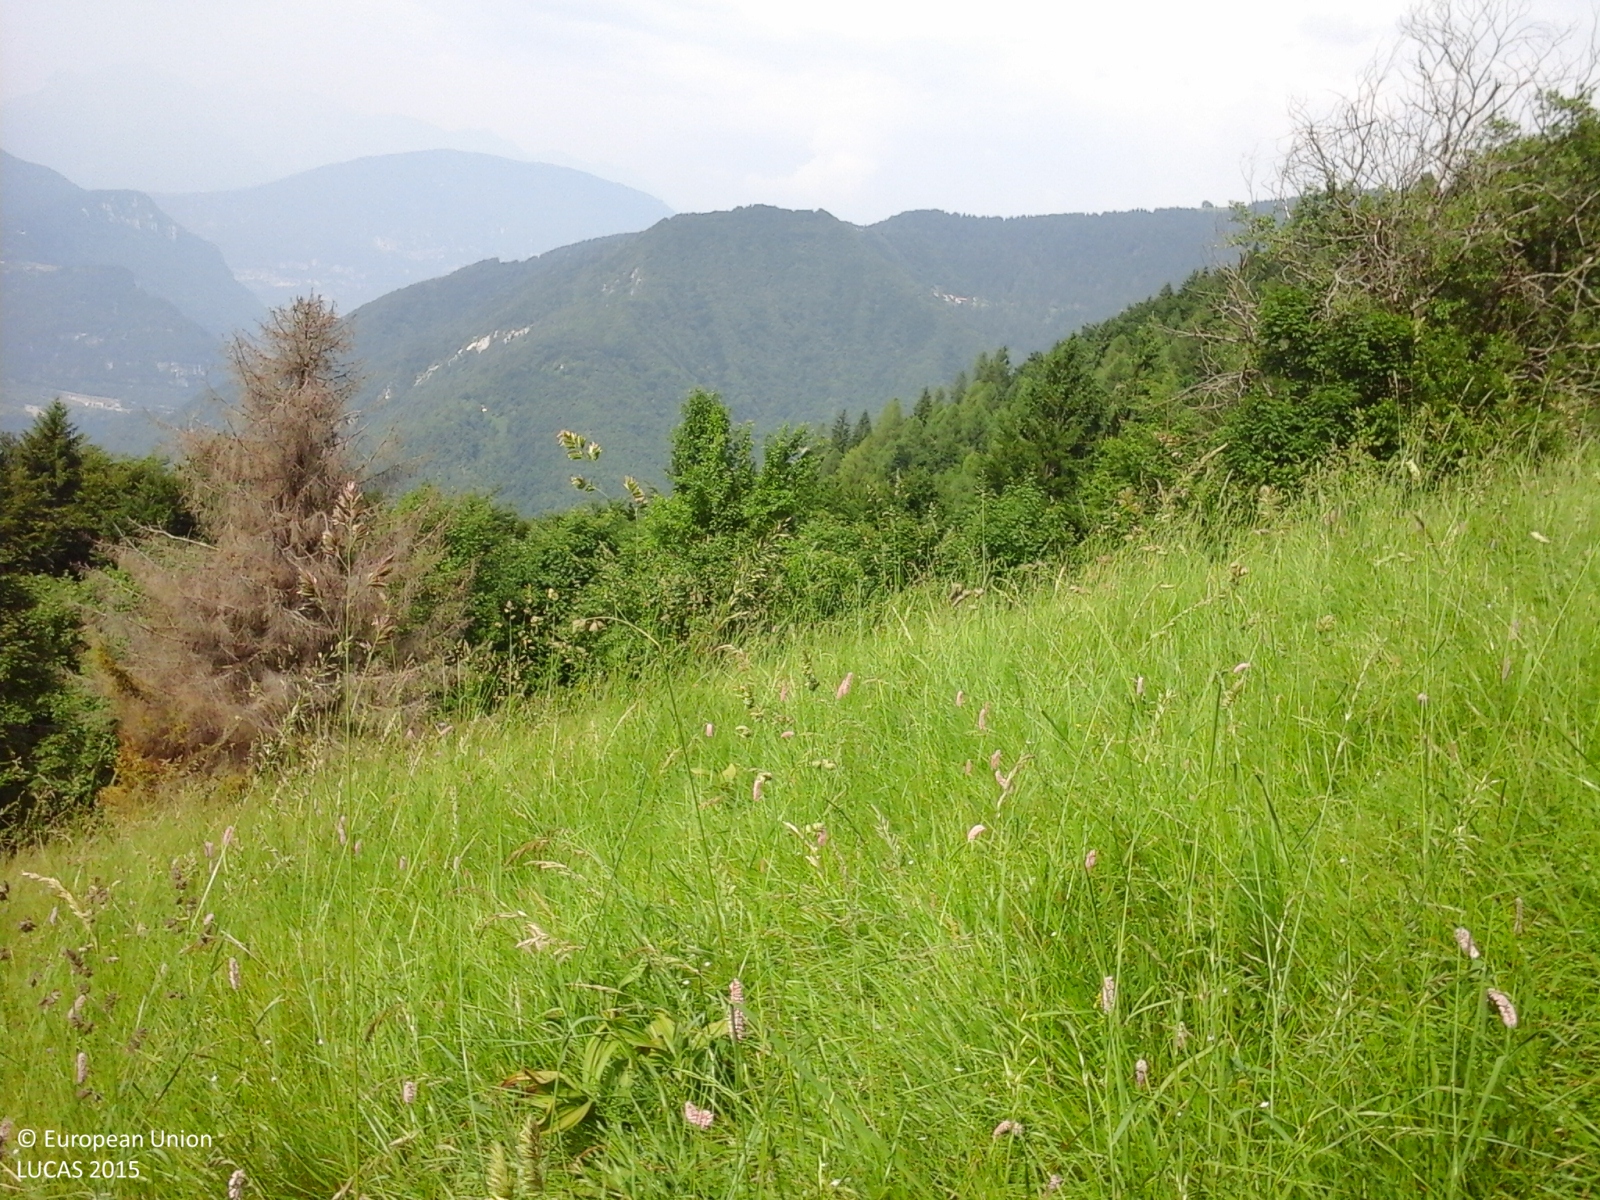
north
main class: Woodland
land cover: Broadleaved woodland
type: thermophilous deciduous forest
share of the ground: > 75 %
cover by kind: broadleaved forest trees 100 %
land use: Semi-natural and natural areas not in use
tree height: > 5 m
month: June
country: IT
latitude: 45.9402
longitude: 11.7646
